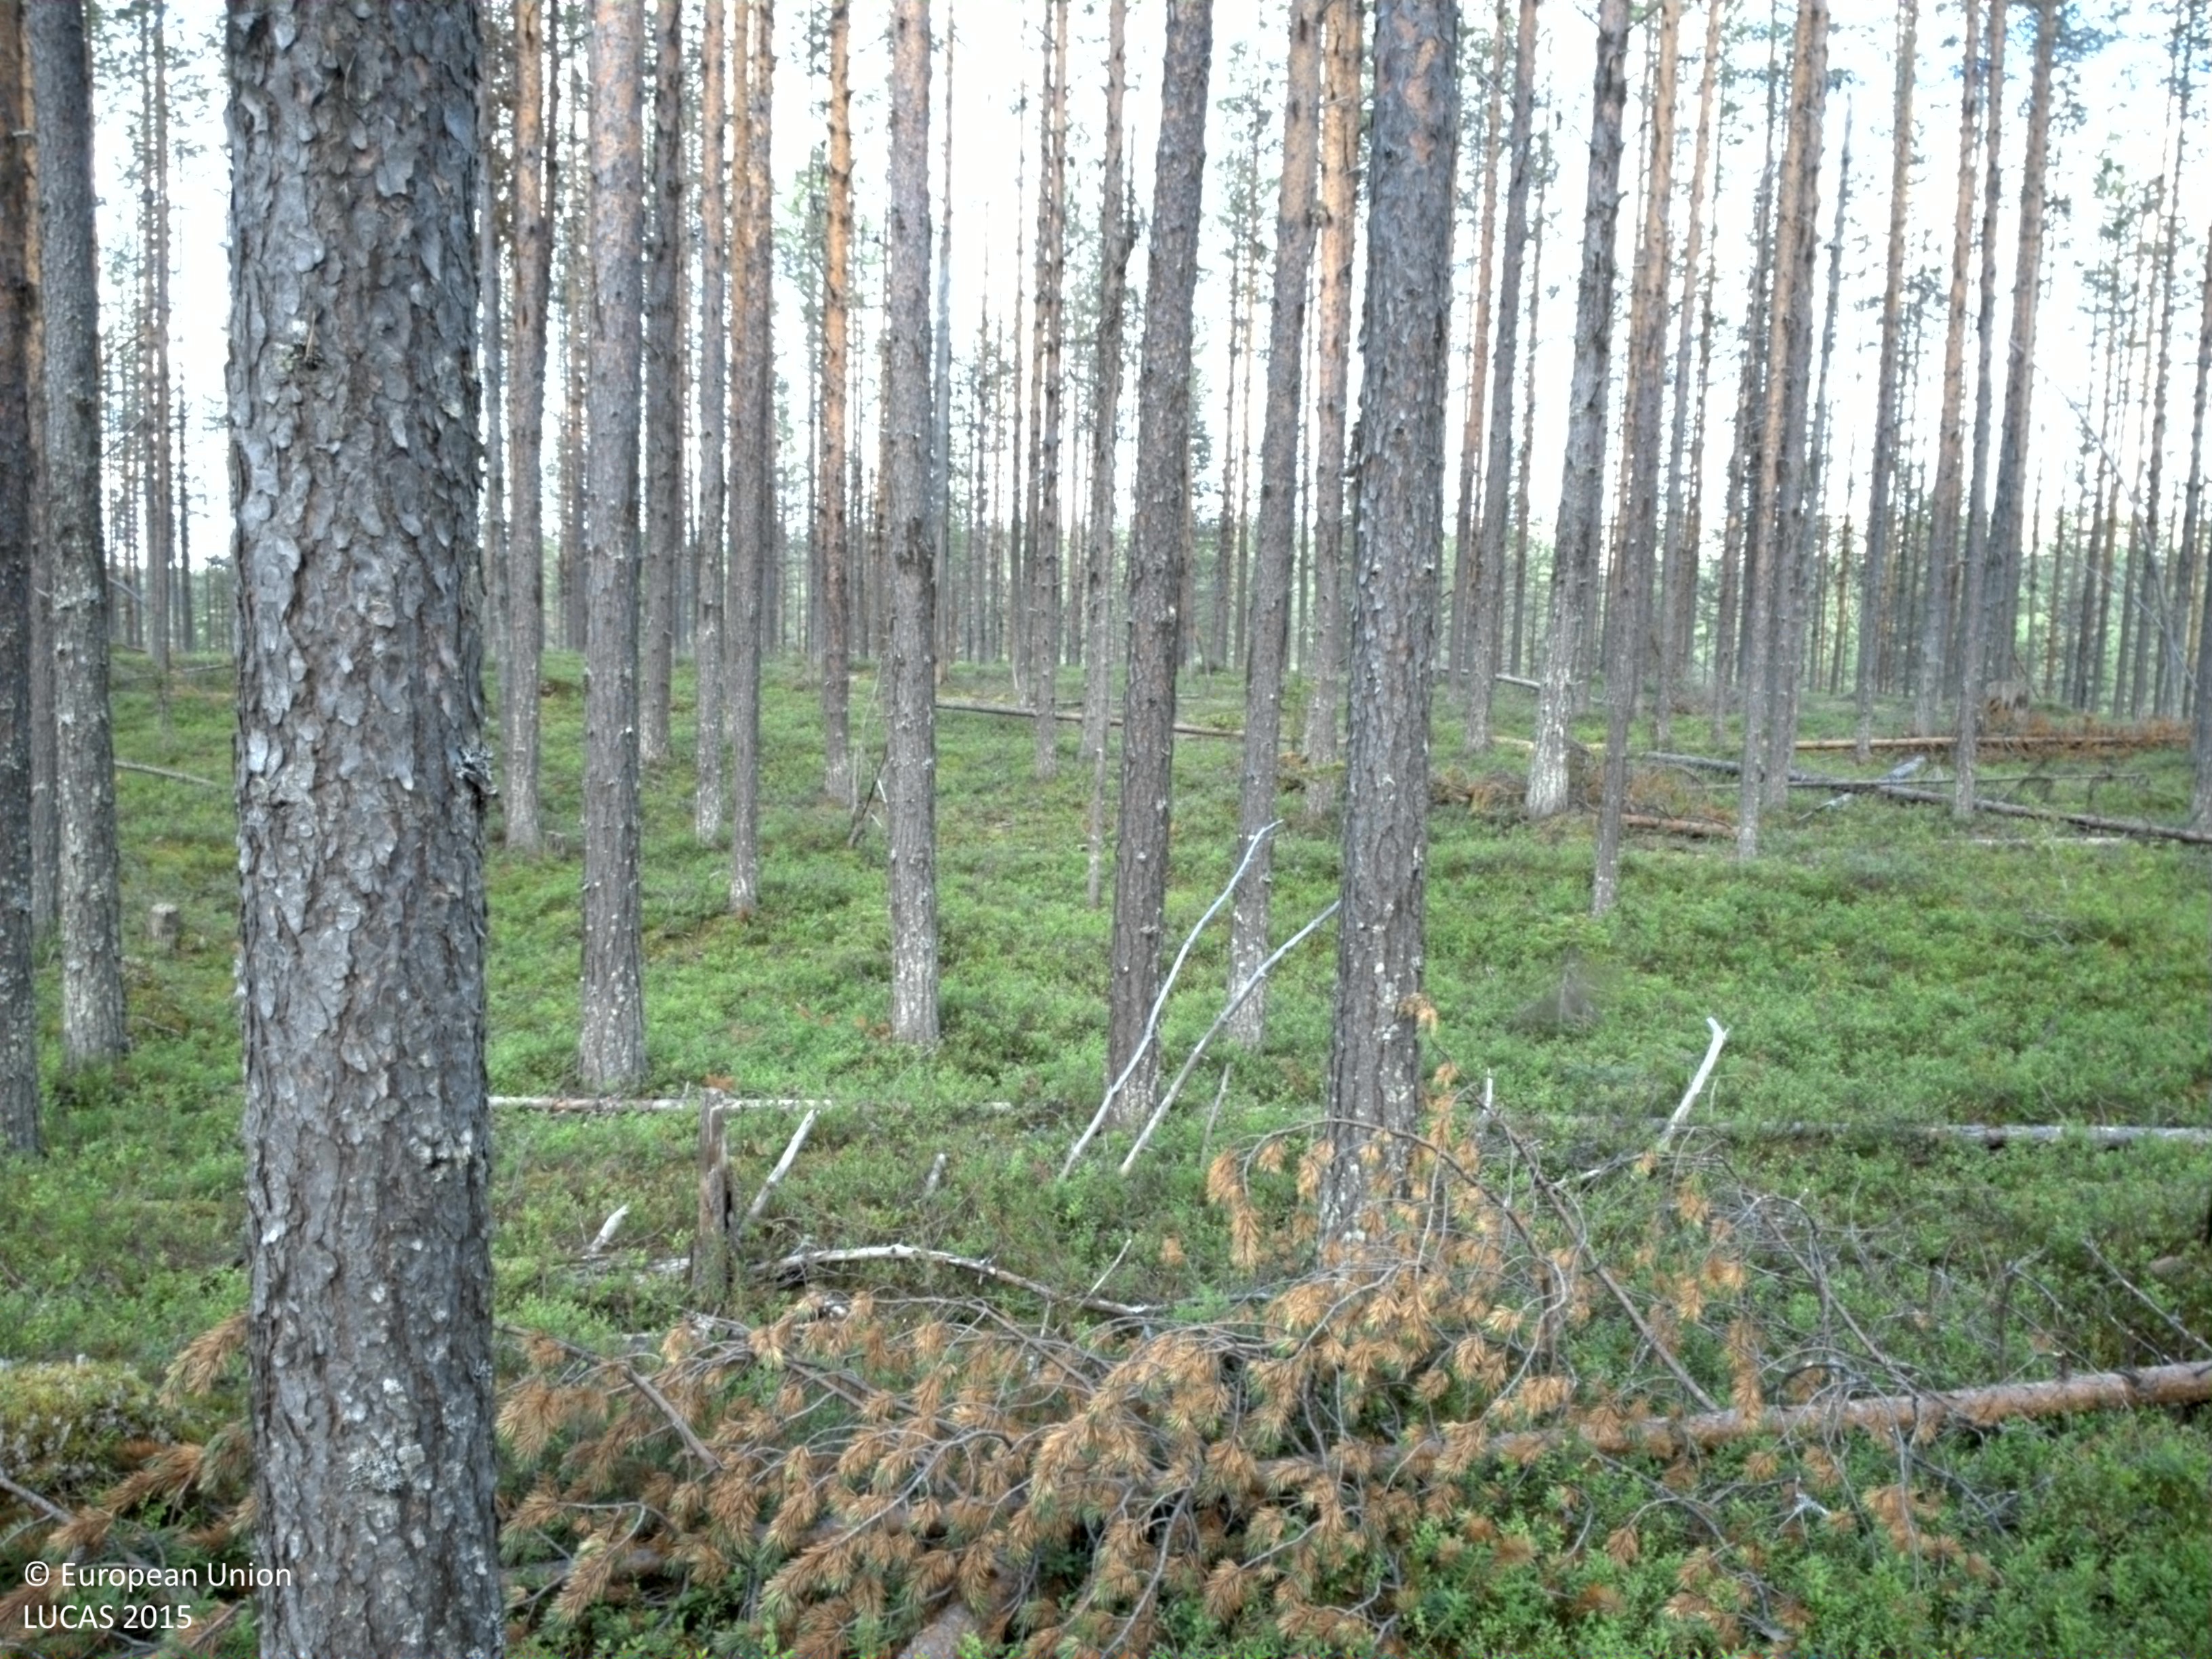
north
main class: Woodland
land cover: Pine dominated coniferous woodland
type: boreal forest
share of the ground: 25 - 50 %
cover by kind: shrubs 65 %, coniferous forest trees 35 %
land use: Forestry
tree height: > 5 m
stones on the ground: < 10 %
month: August
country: SE
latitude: 66.4988
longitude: 20.7671
